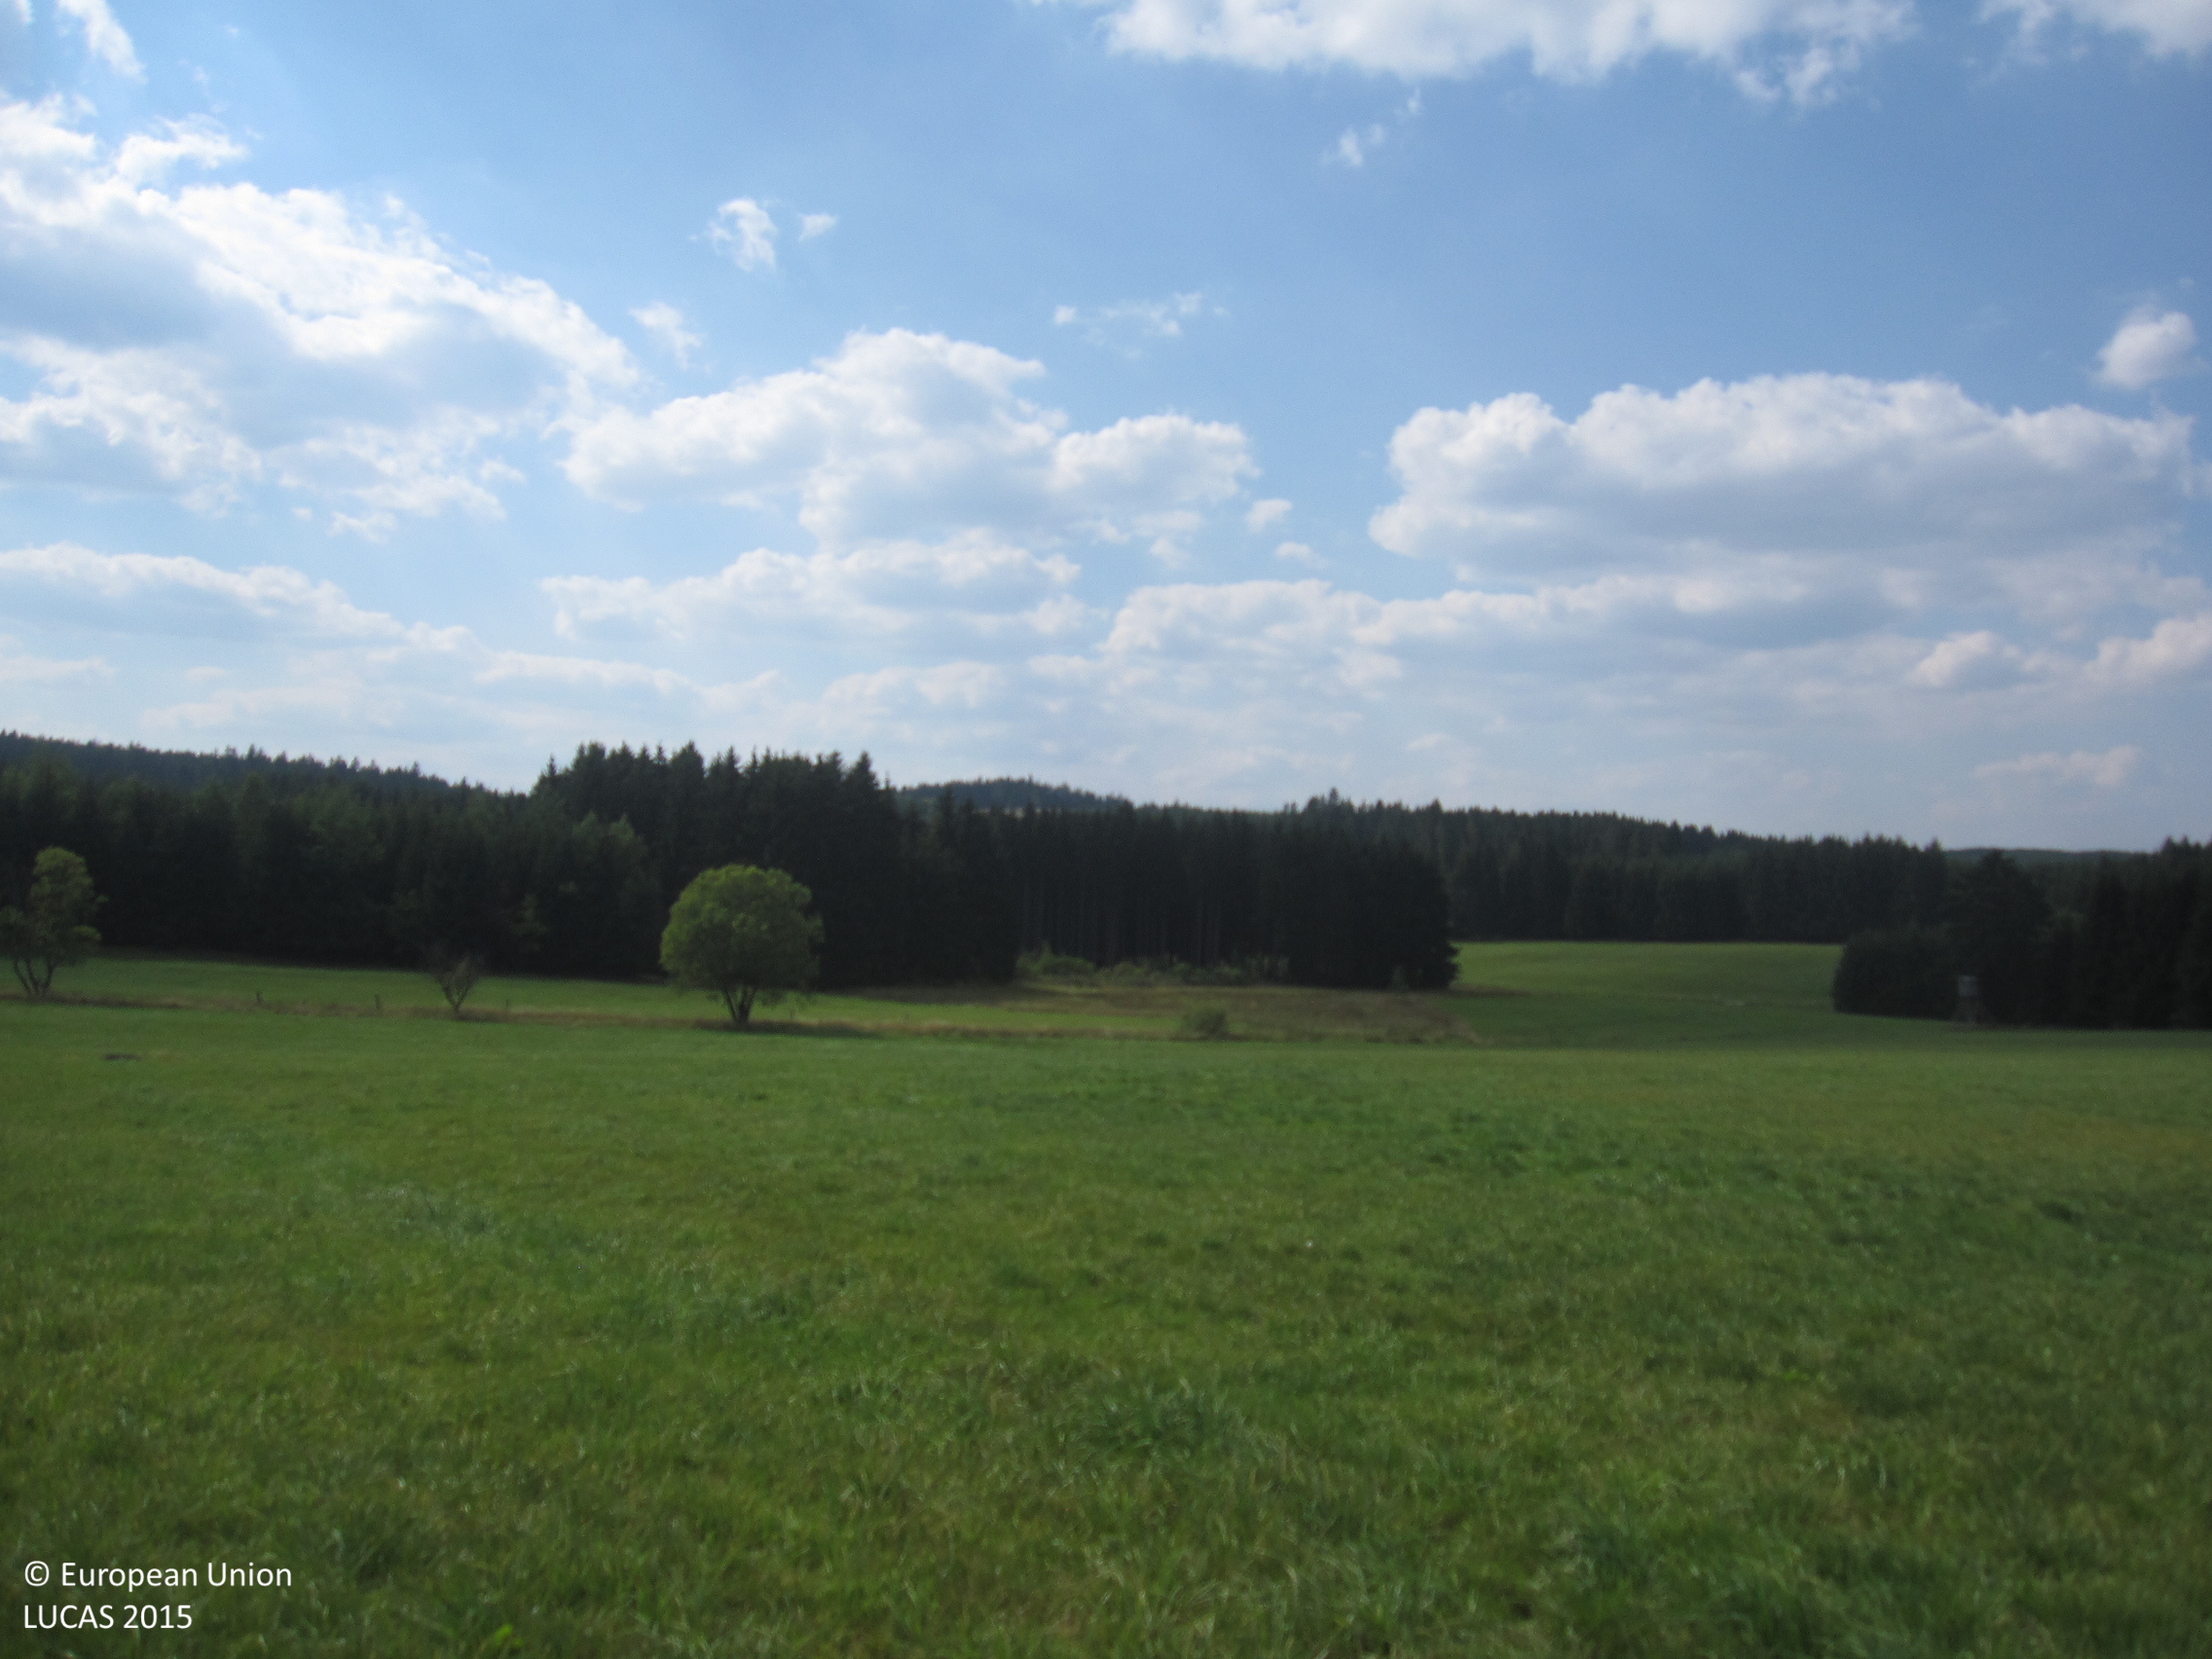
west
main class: Grassland
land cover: Grassland without tree/shrub cover
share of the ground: > 75 %
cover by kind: herbaceous plants 95 %, unconsolidated bare surface 5 %
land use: Agriculture (excluding fallow land and kitchen gardens)
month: August
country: DE
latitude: 50.4249
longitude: 11.5902
